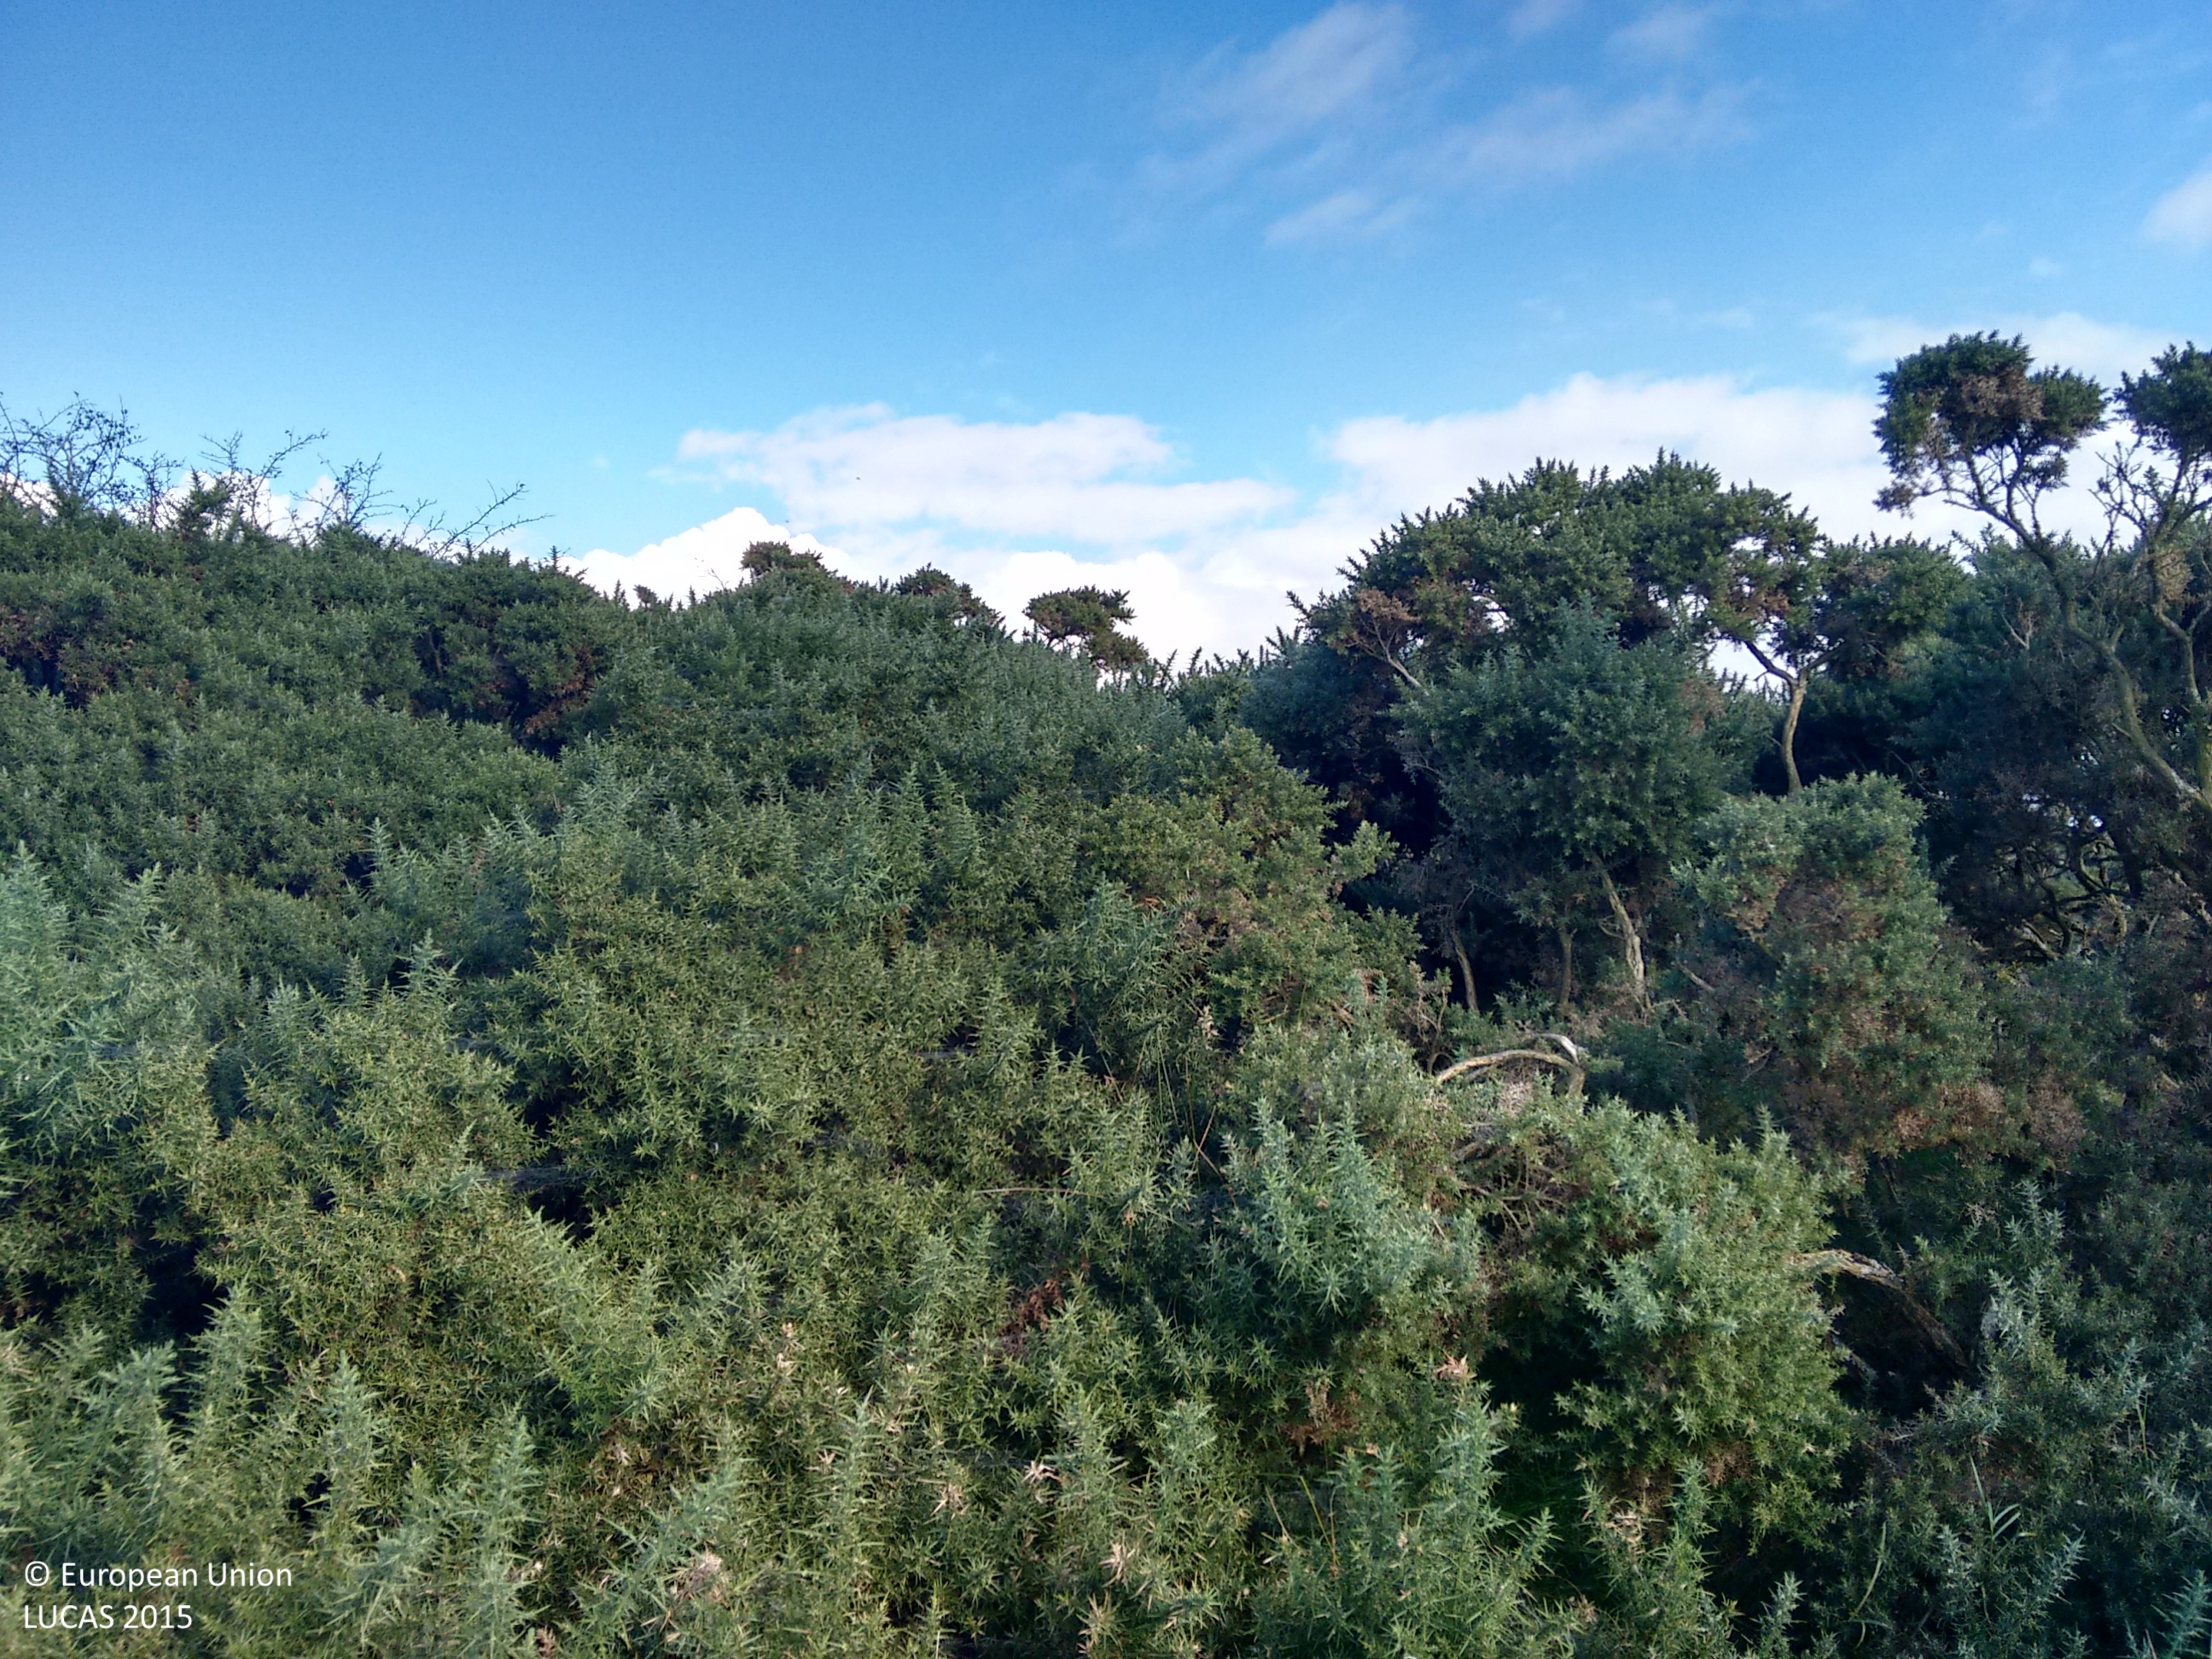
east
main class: Grassland
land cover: Grassland without tree/shrub cover
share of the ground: > 75 %
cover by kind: herbaceous plants 100 %
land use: Agriculture (excluding fallow land and kitchen gardens)
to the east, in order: Grassland without tree/shrub cover; Shrubland without tree cover; Grass margins; Fences; Managed hedges; Fences; Grassland without tree/shrub cover; Fences; Managed hedges; Fences; Grassland without tree/shrub cover
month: October
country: GB
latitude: 52.2793
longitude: -3.9446
